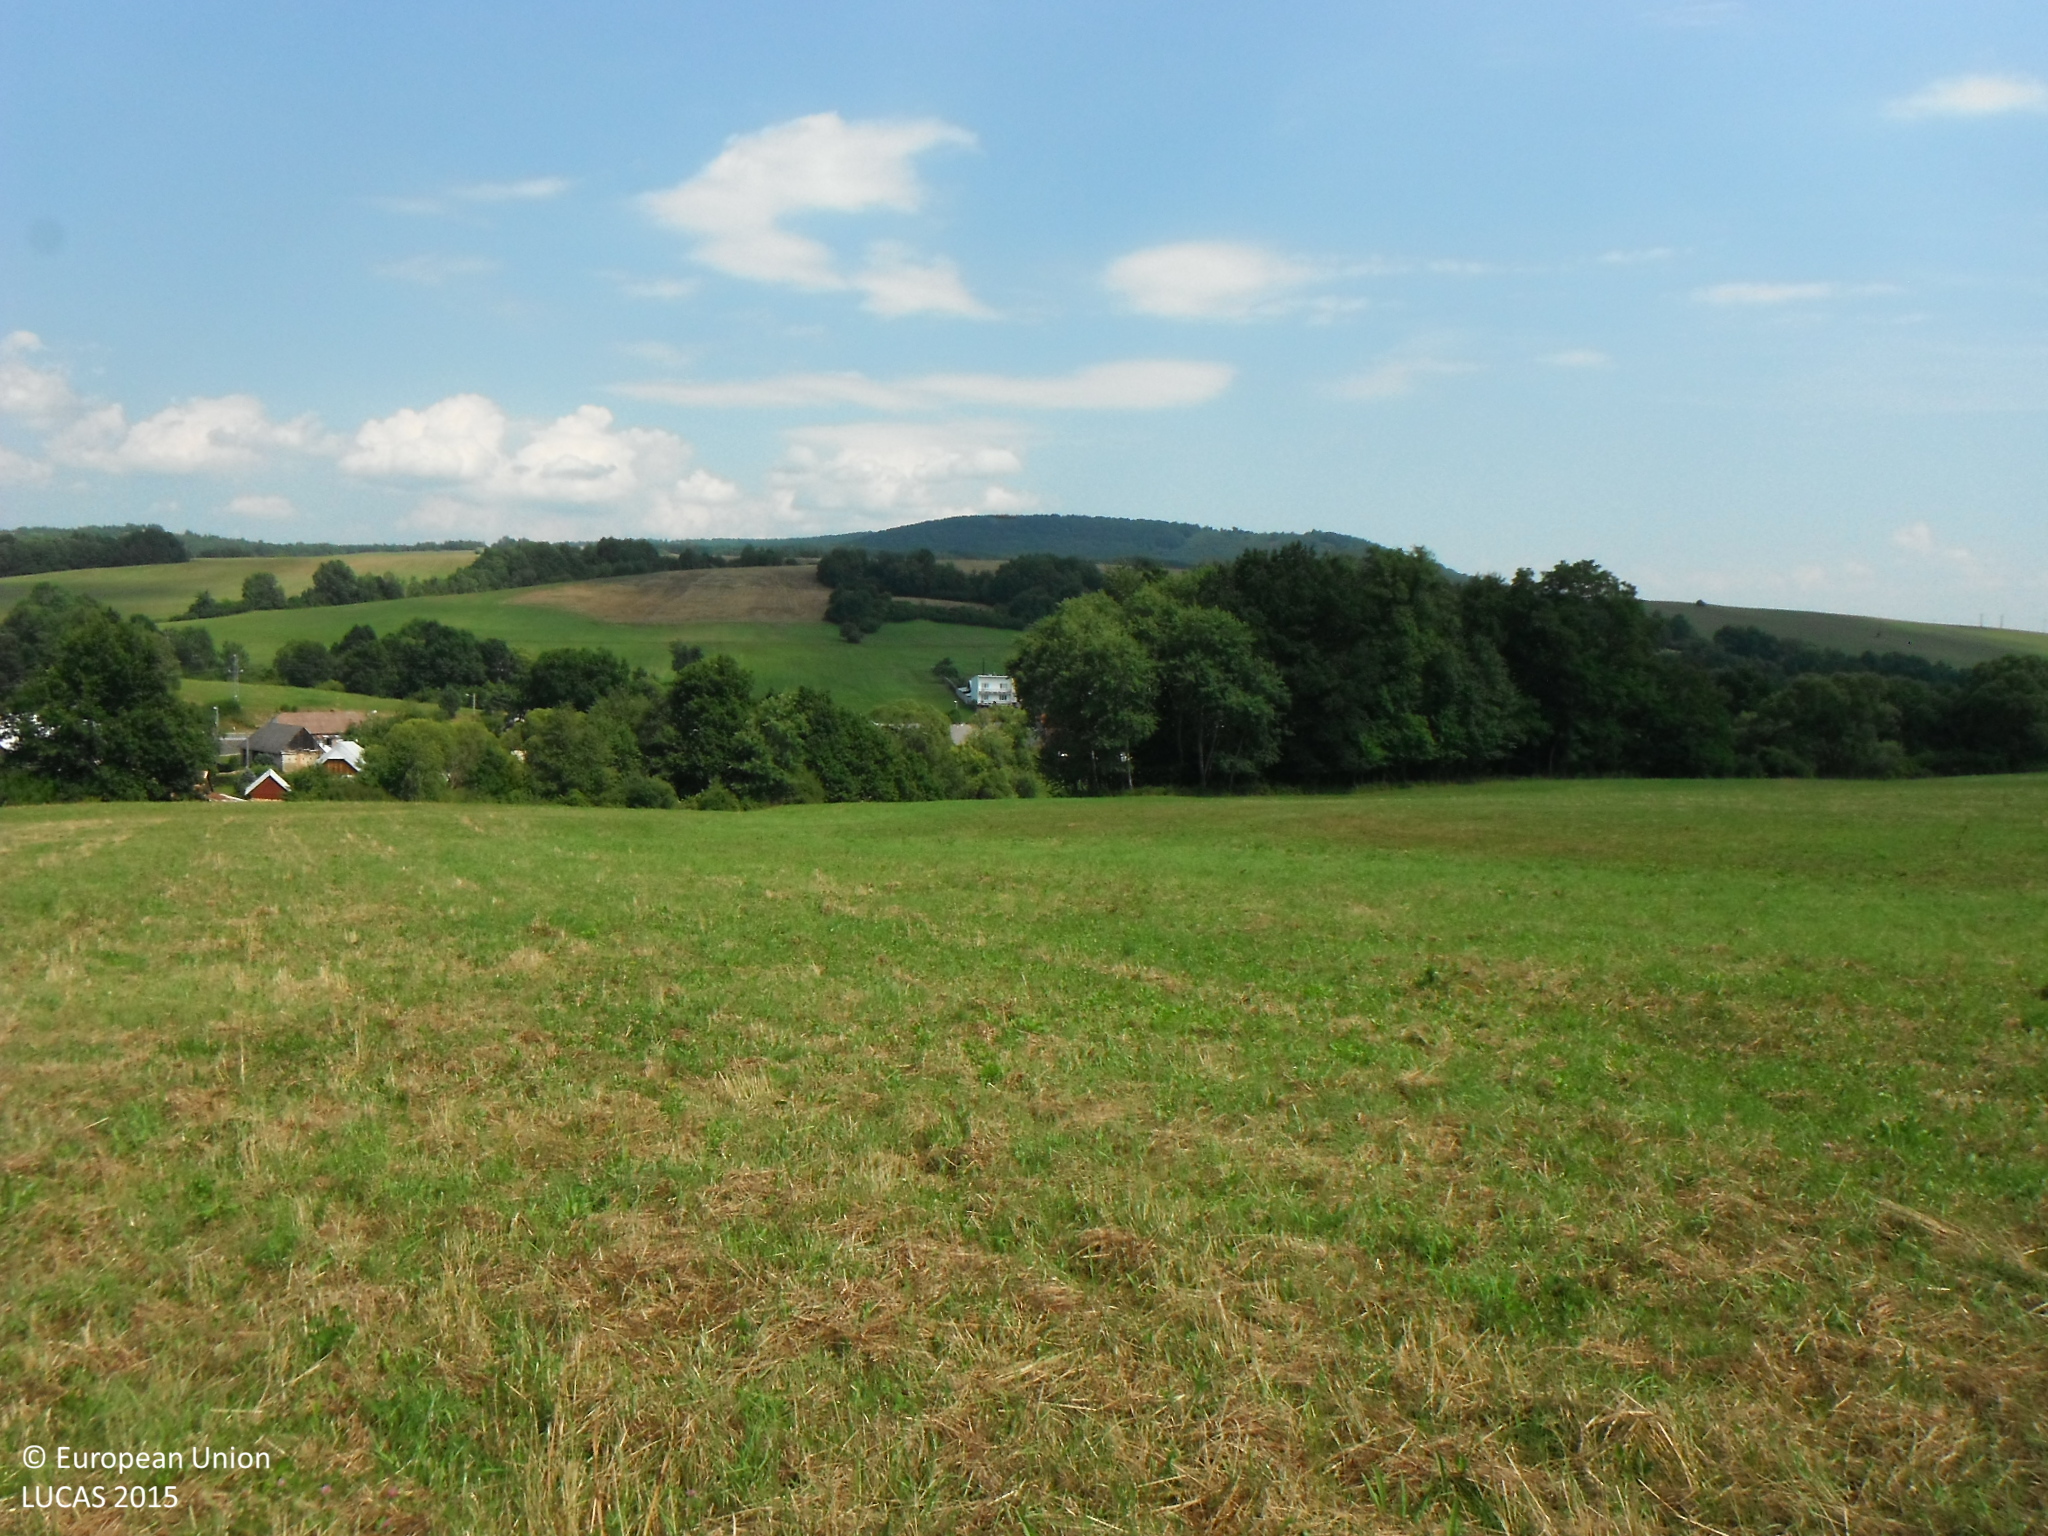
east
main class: Grassland
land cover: Grassland without tree/shrub cover
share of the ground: > 75 %
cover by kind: herbaceous plants 100 %
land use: Agriculture (excluding fallow land and kitchen gardens)
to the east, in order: Grassland without tree/shrub cover; Broadleaved woodland; Rivers and streams; Broadleaved woodland; Other bare soil
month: July
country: SK
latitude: 49.3676
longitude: 21.4647
